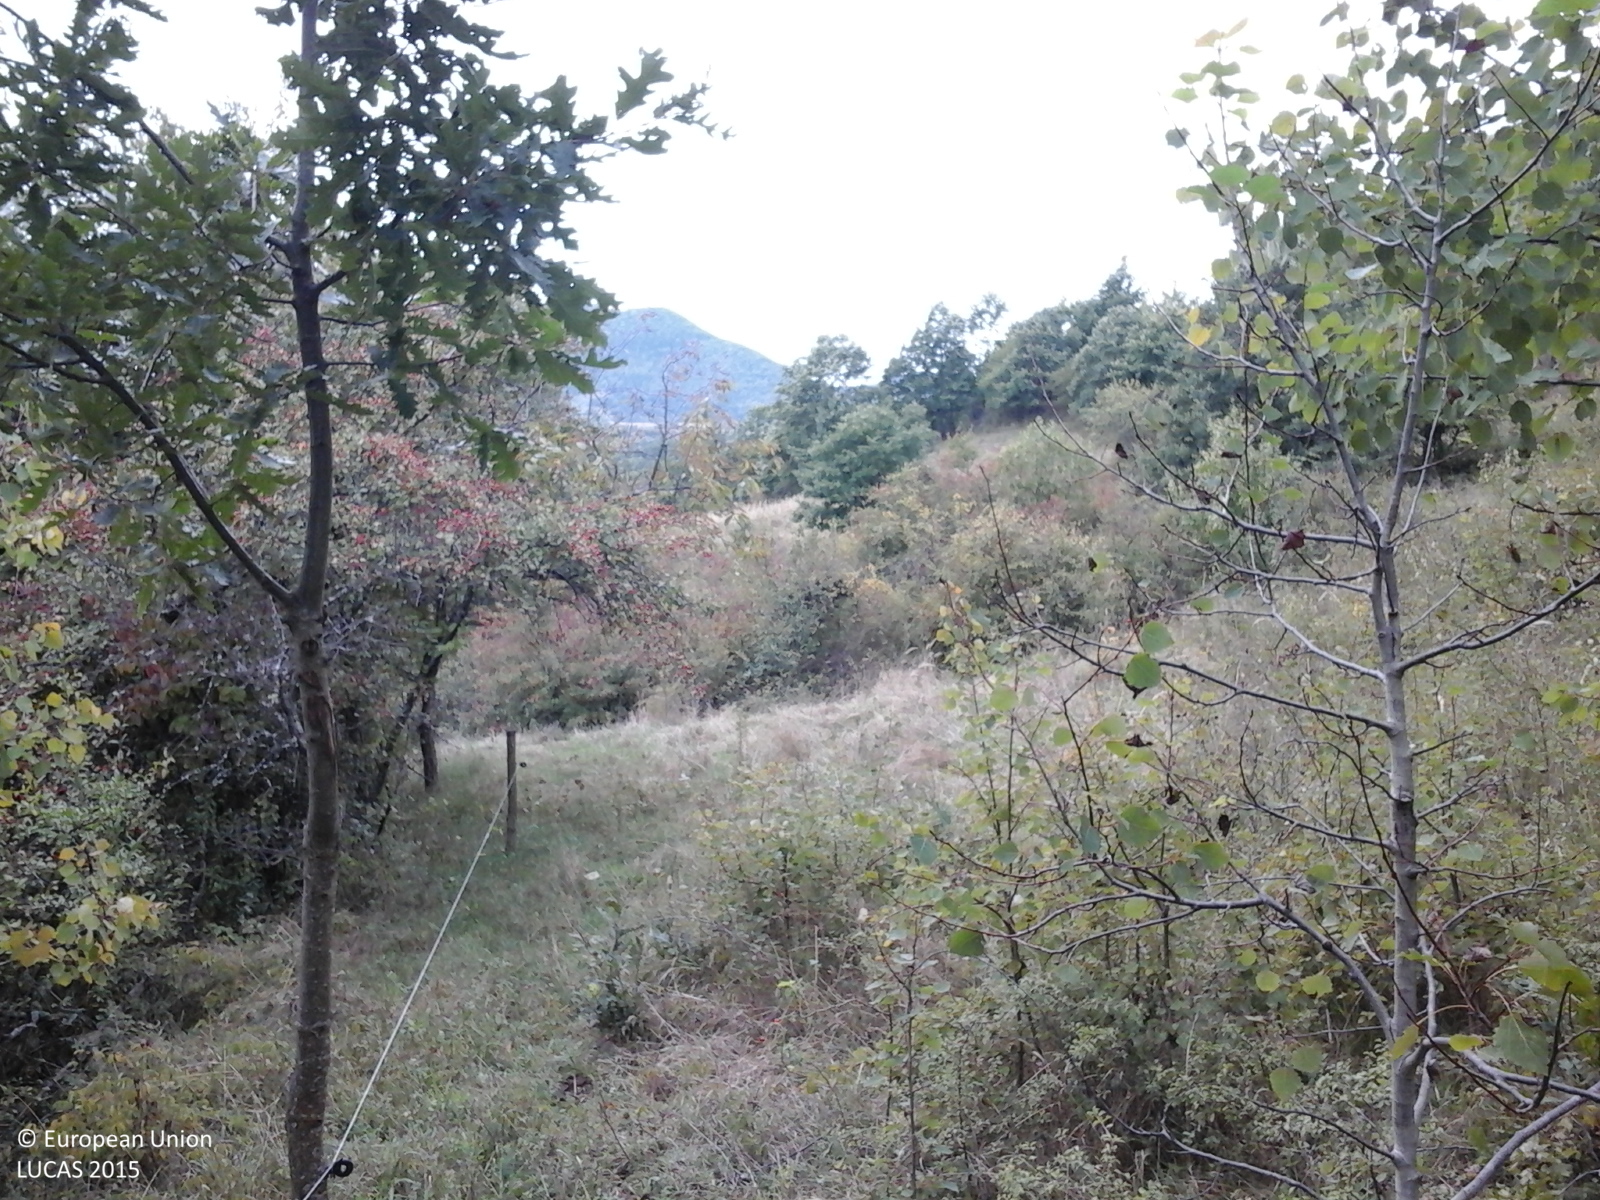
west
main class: Woodland
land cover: Broadleaved woodland
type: acidophilous oak and oak-birch forest
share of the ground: > 75 %
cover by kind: broadleaved forest trees 100 %
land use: Forestry
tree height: > 5 m
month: September
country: RO
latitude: 45.9960
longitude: 23.1114
